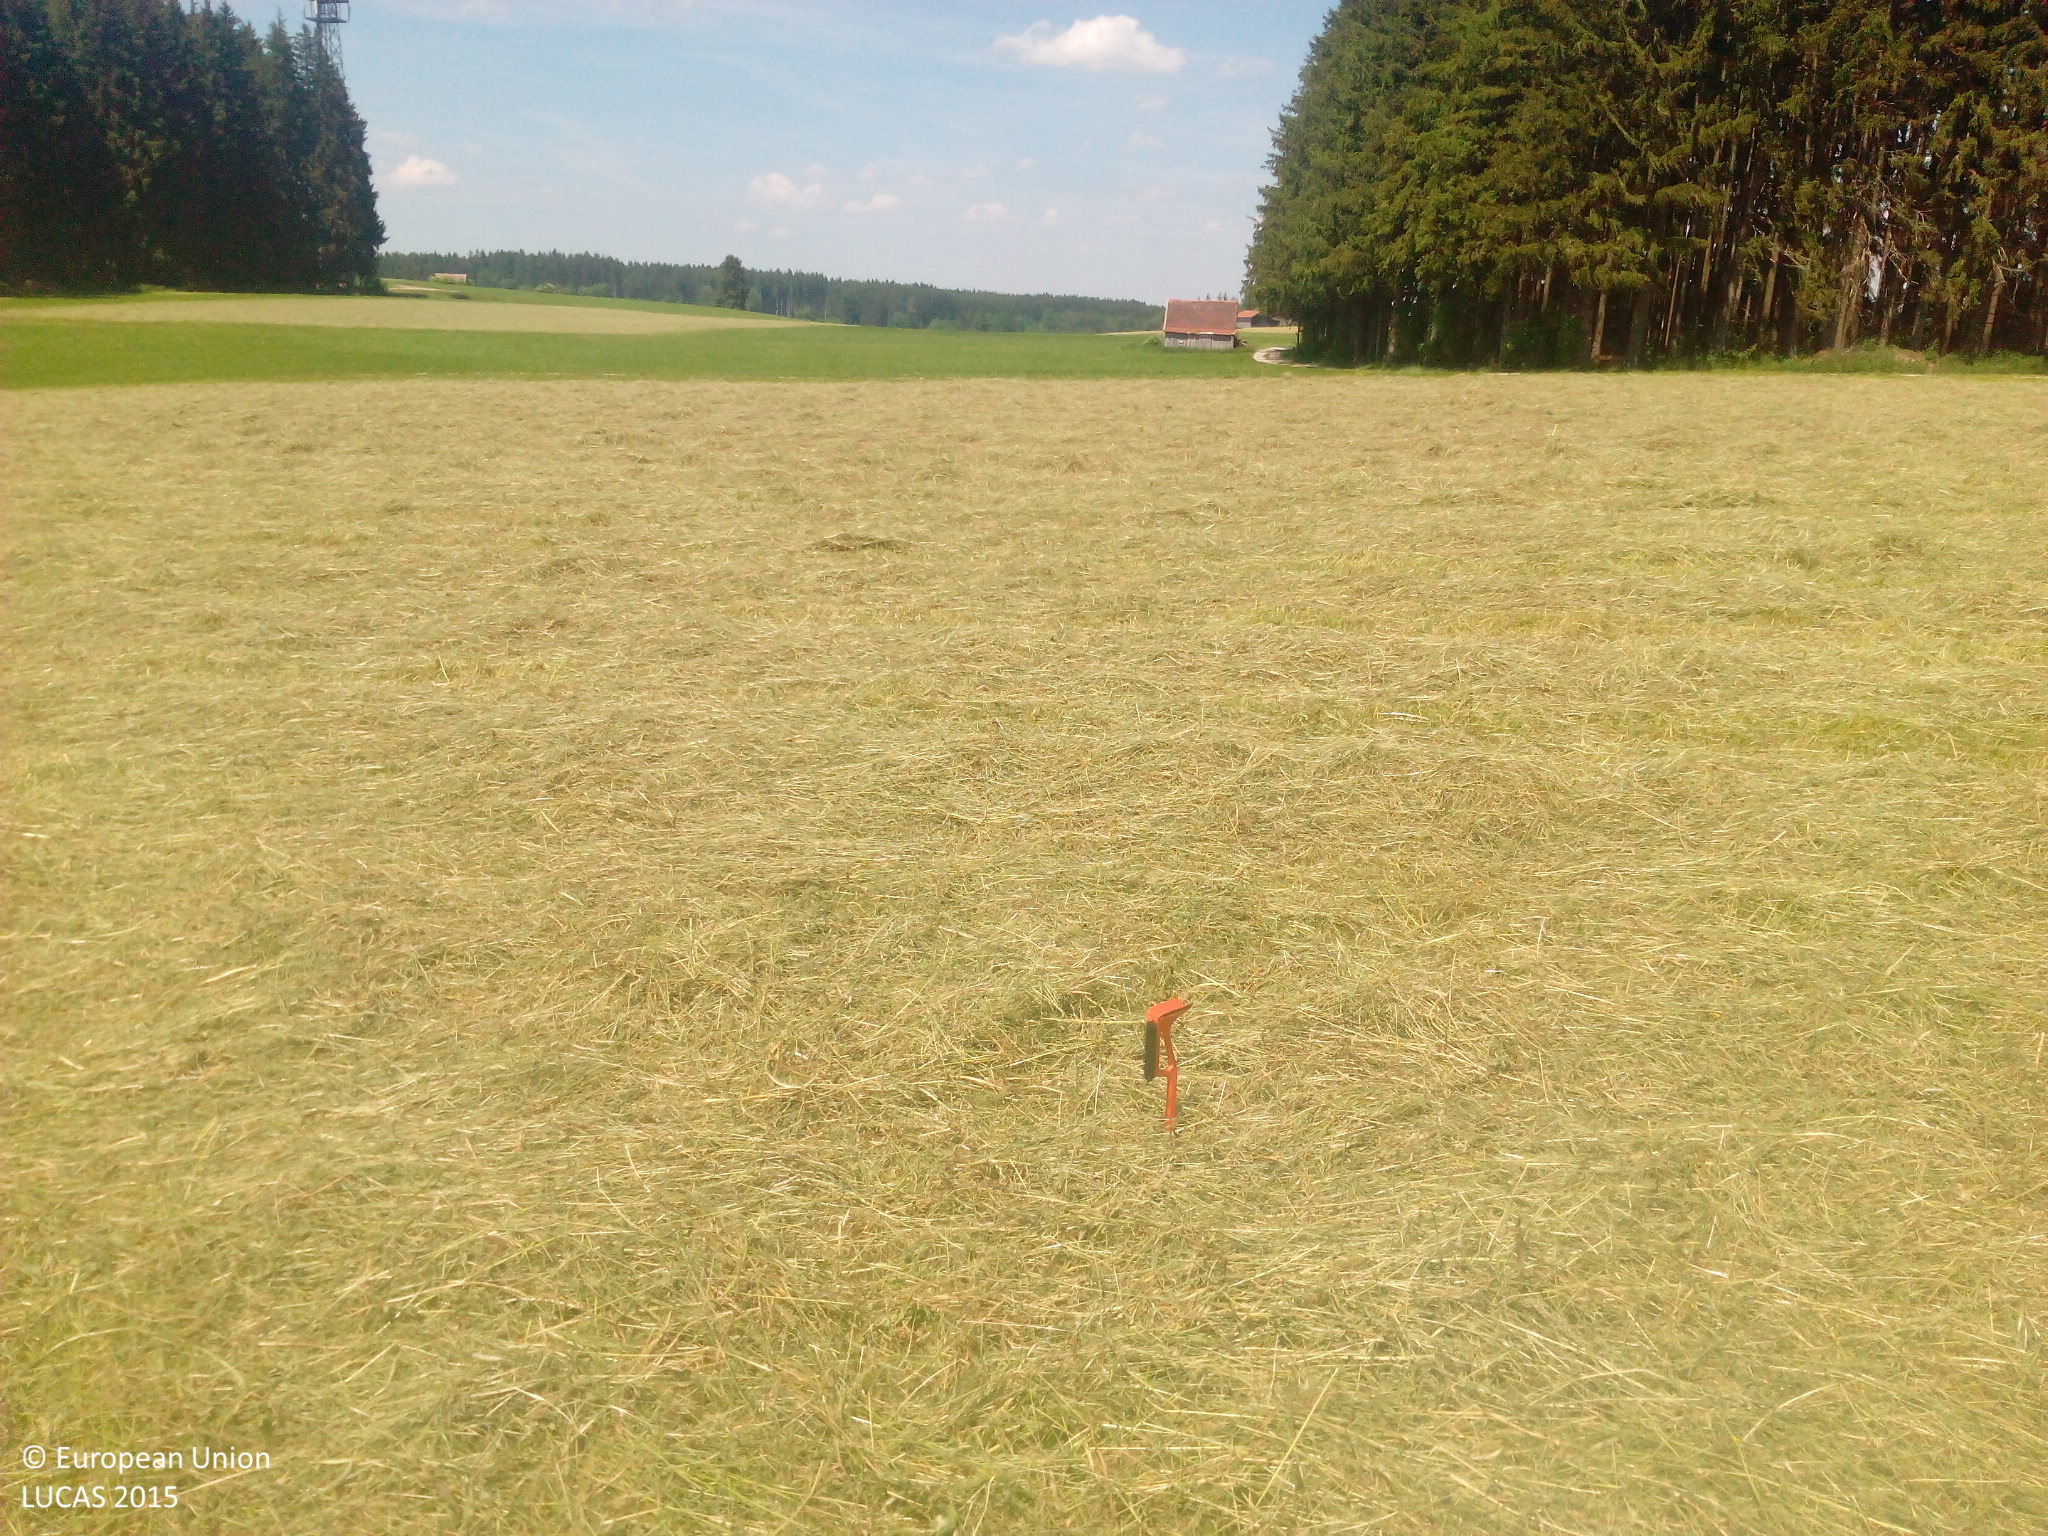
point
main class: Grassland
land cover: Grassland without tree/shrub cover
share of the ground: > 75 %
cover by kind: herbaceous plants 100 %
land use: Agriculture (excluding fallow land and kitchen gardens)
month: June
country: DE
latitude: 47.8624
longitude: 10.5209
